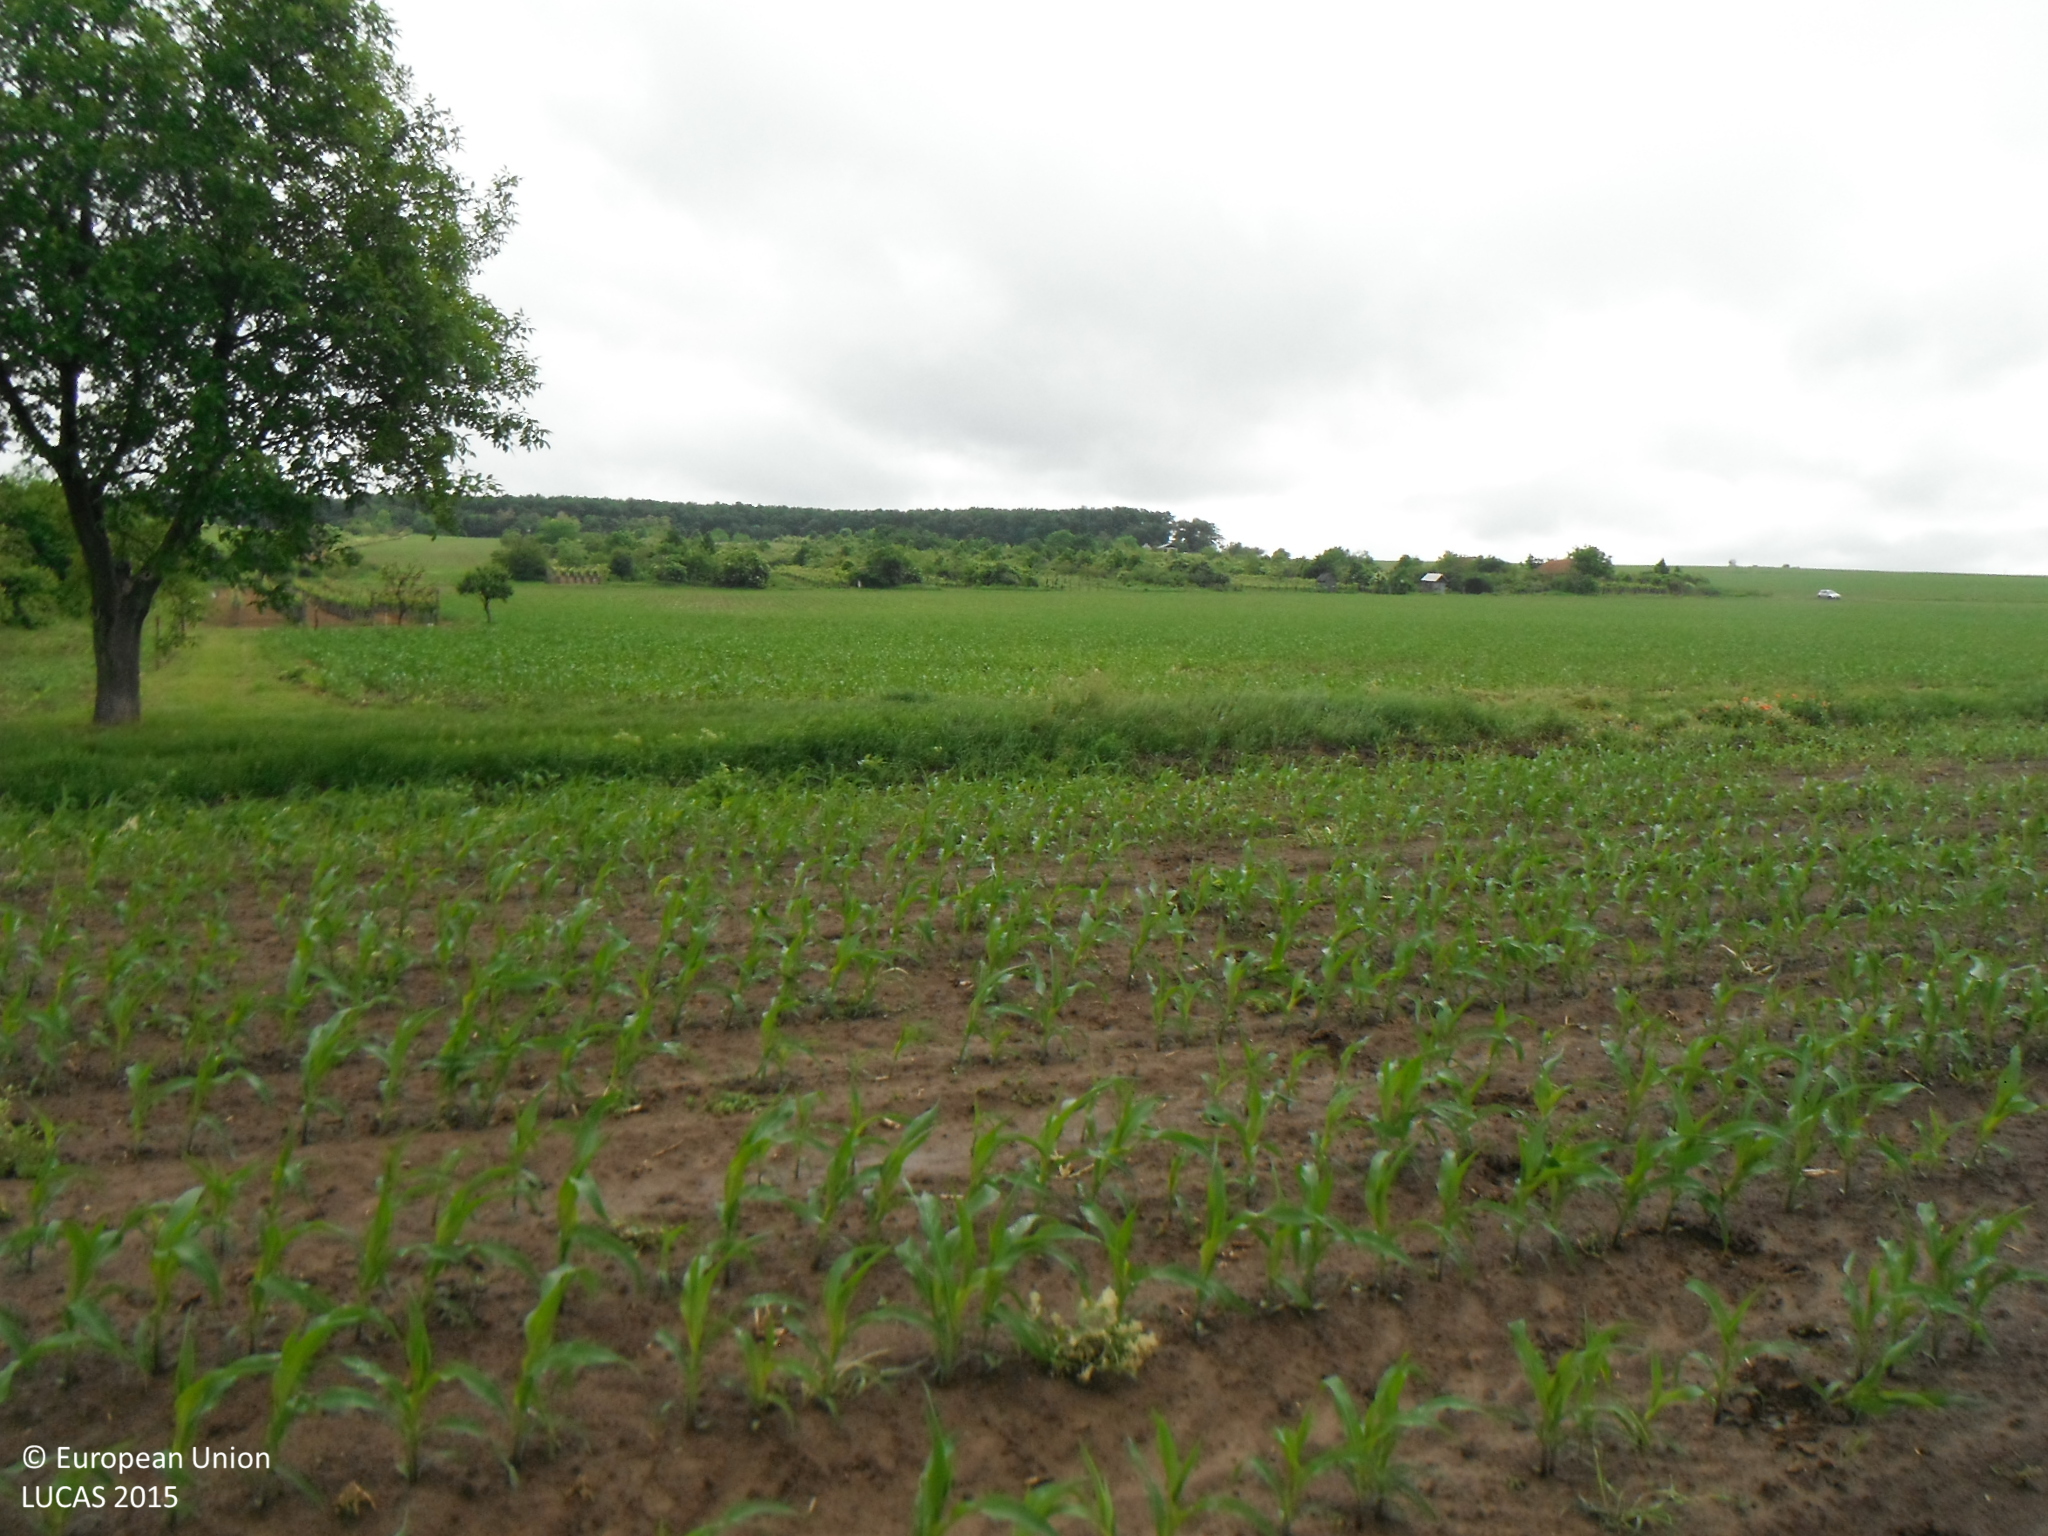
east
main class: Cropland
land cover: Maize
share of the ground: 25 - 50 %
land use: Agriculture (excluding fallow land and kitchen gardens)
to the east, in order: Maize; Tracks; Maize; Tracks; Grassland without tree/shrub cover
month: May
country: SK
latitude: 48.1687
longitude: 18.2299
